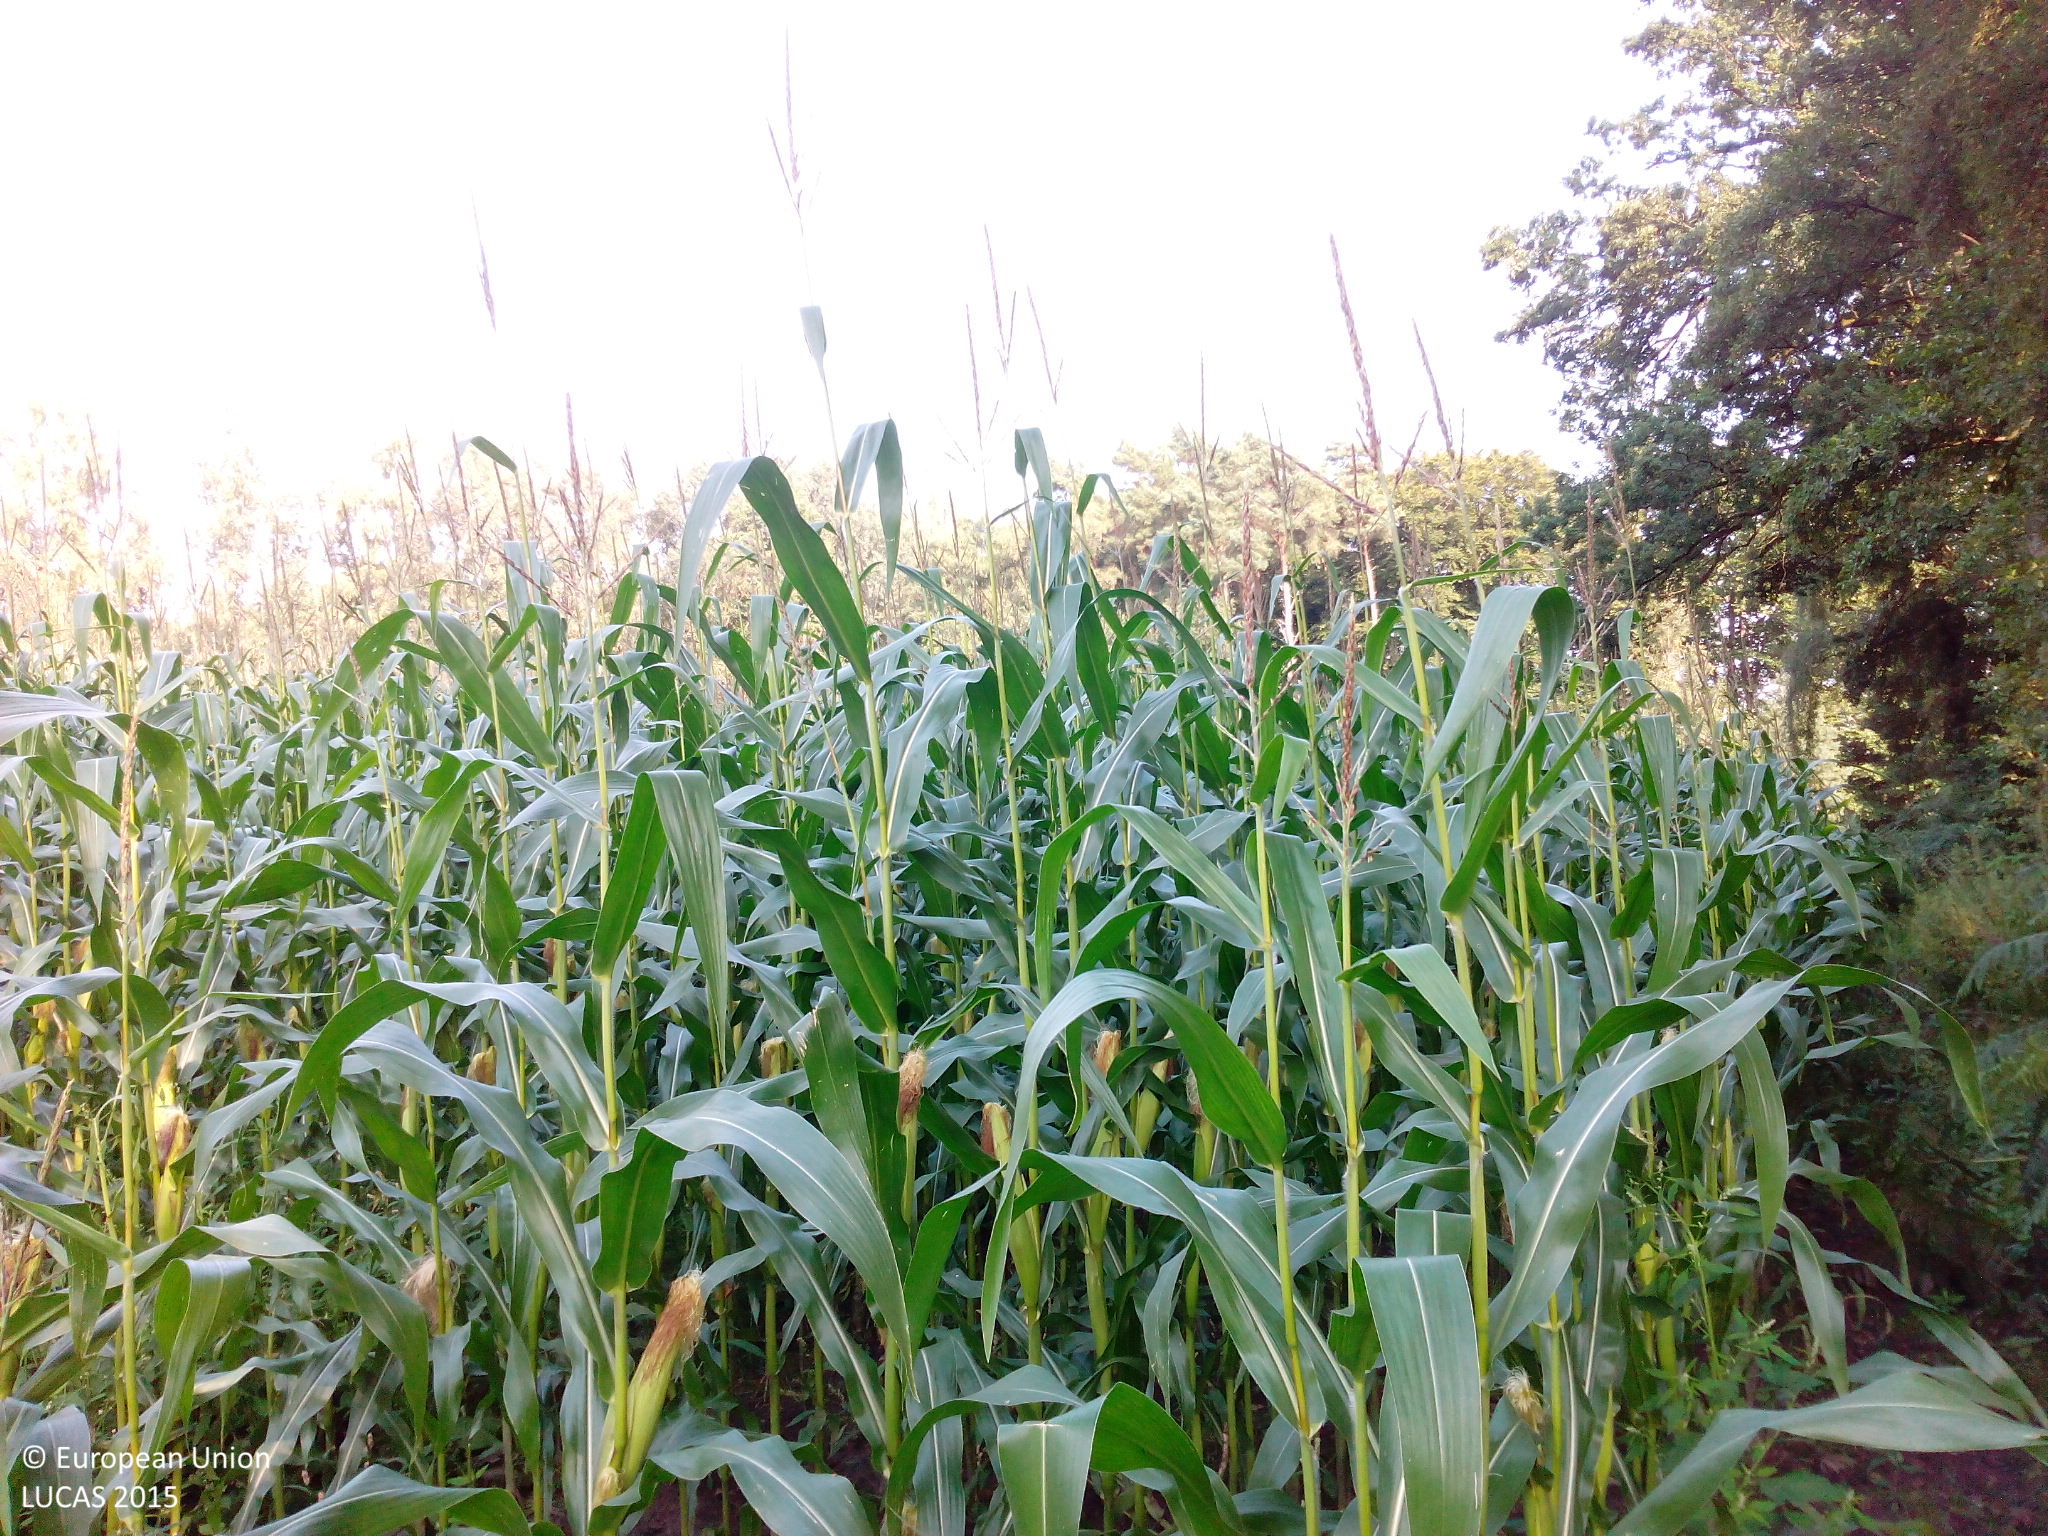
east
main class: Cropland
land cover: Maize
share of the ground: > 75 %
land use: Agriculture (excluding fallow land and kitchen gardens)
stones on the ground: < 10 %
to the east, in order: Maize; Shruby margins; Broadleaved woodland; Maize; Grass margins; Paved roads, cycling and walking lanes; Grass margins; Paved roads, cycling and walking lanes; Grass margins; Ditches and canals; Spruce dominated mixed woodland; Broadleaved woodland; Paved roads, cycling and walking lanes; Shruby margins; Ditches and canals; Broadleaved woodland
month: August
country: DE
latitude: 52.0366
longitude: 7.9741
